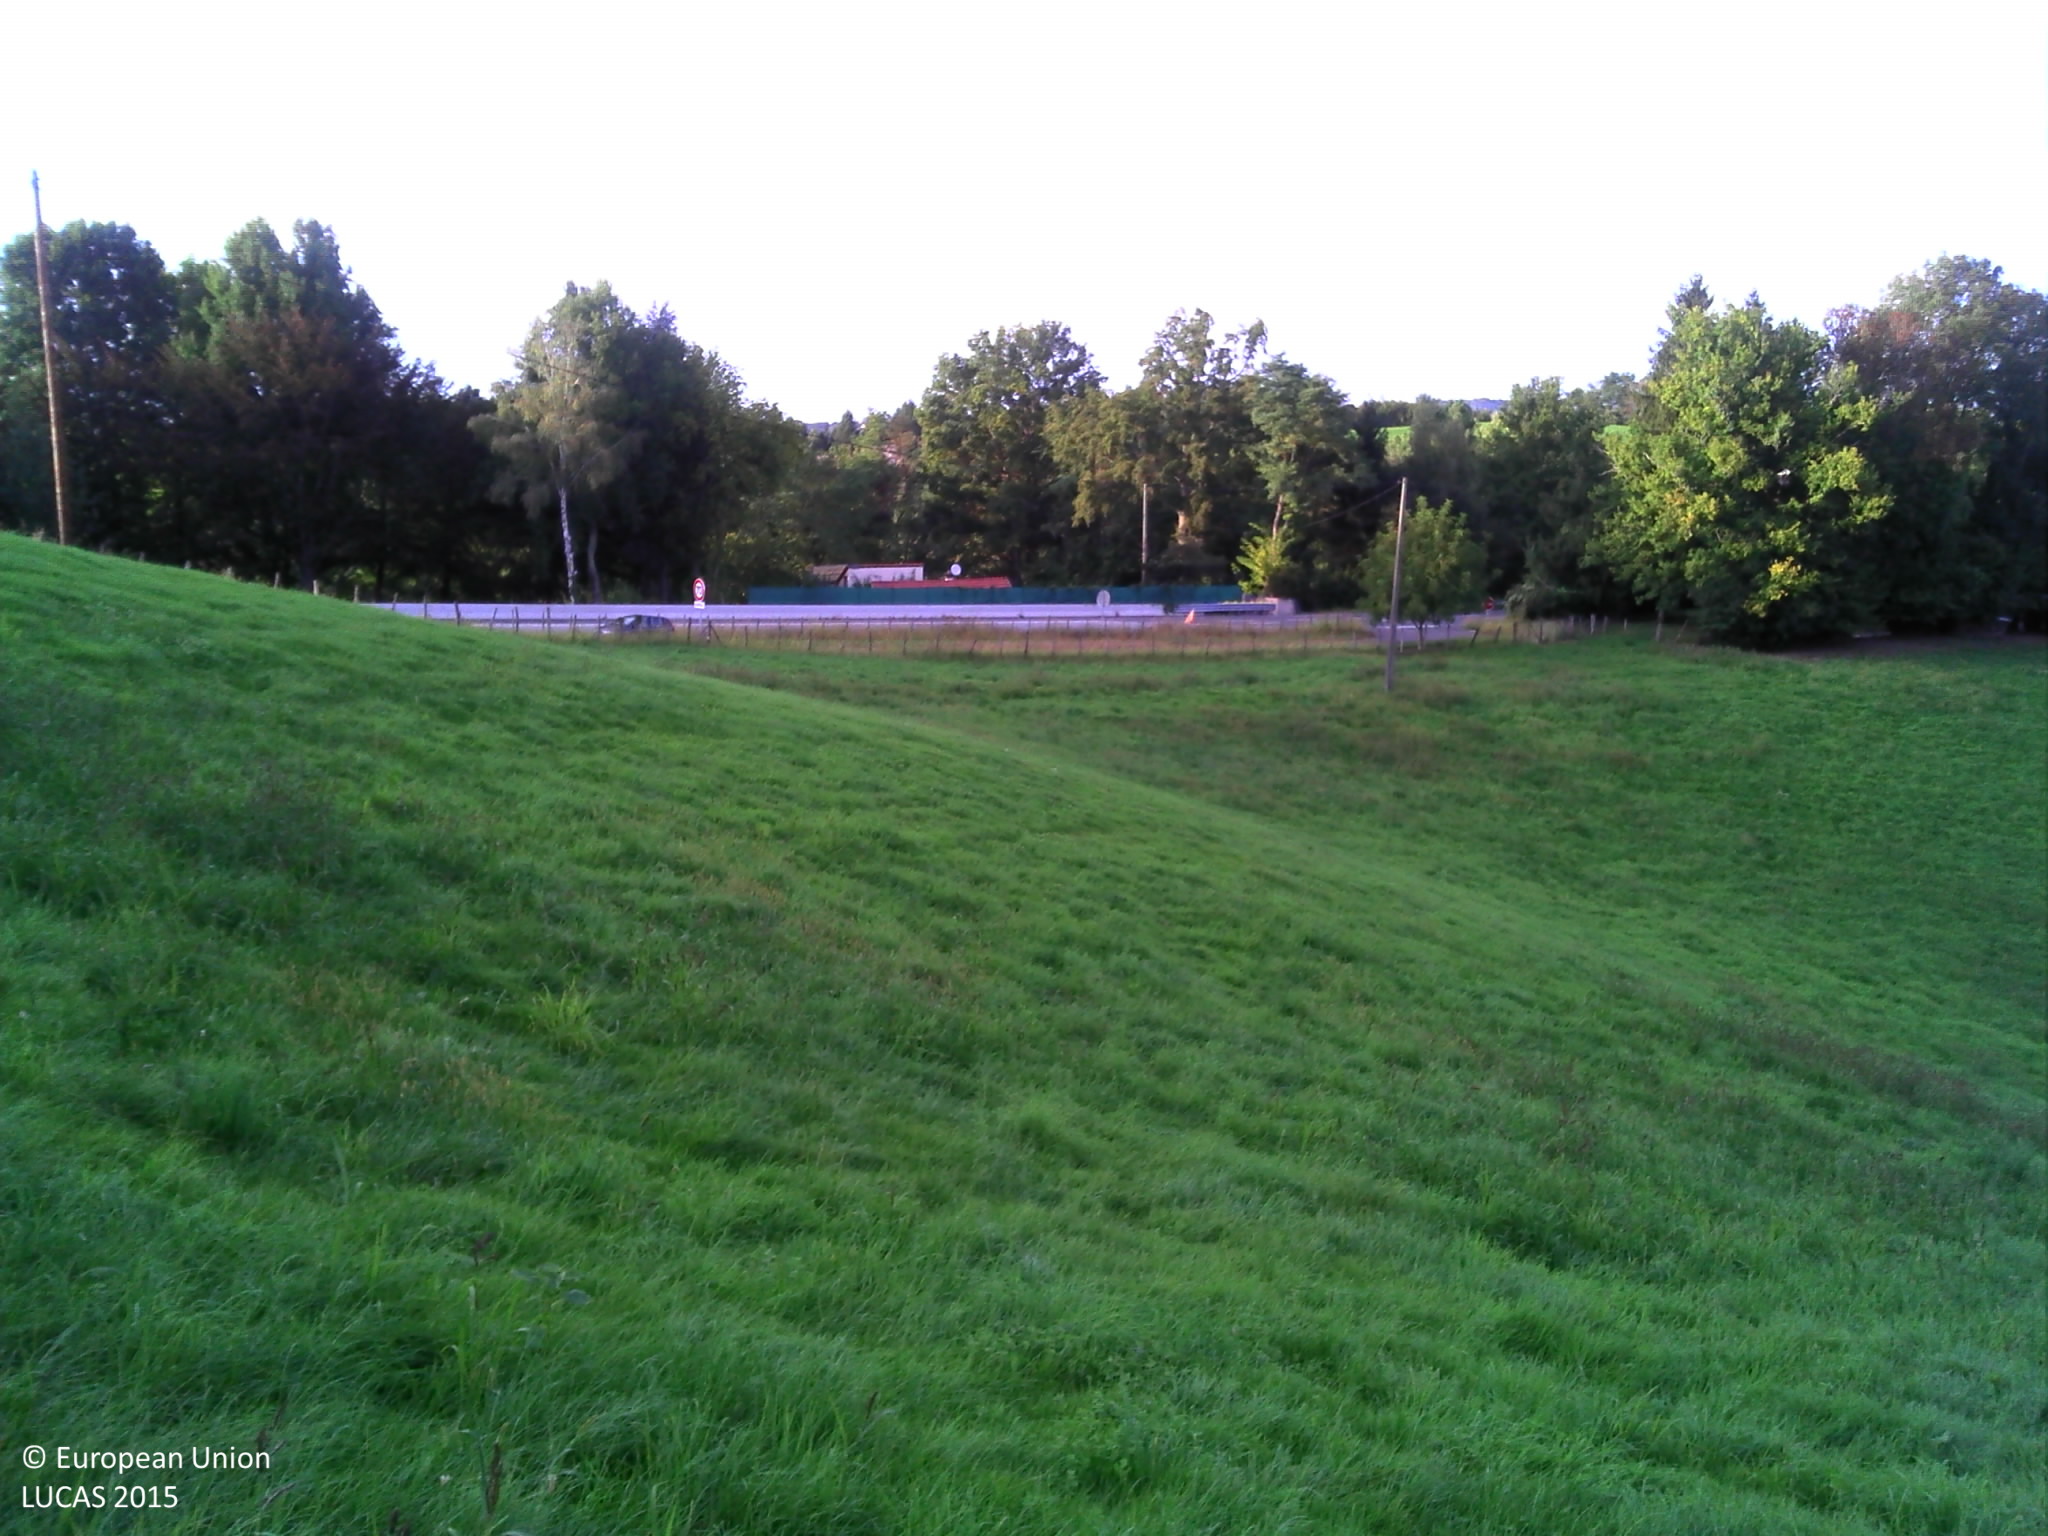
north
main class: Grassland
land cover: Grassland without tree/shrub cover
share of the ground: > 75 %
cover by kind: herbaceous plants 100 %
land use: Agriculture (excluding fallow land and kitchen gardens)
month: September
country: FR
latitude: 43.1875
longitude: -0.4281
